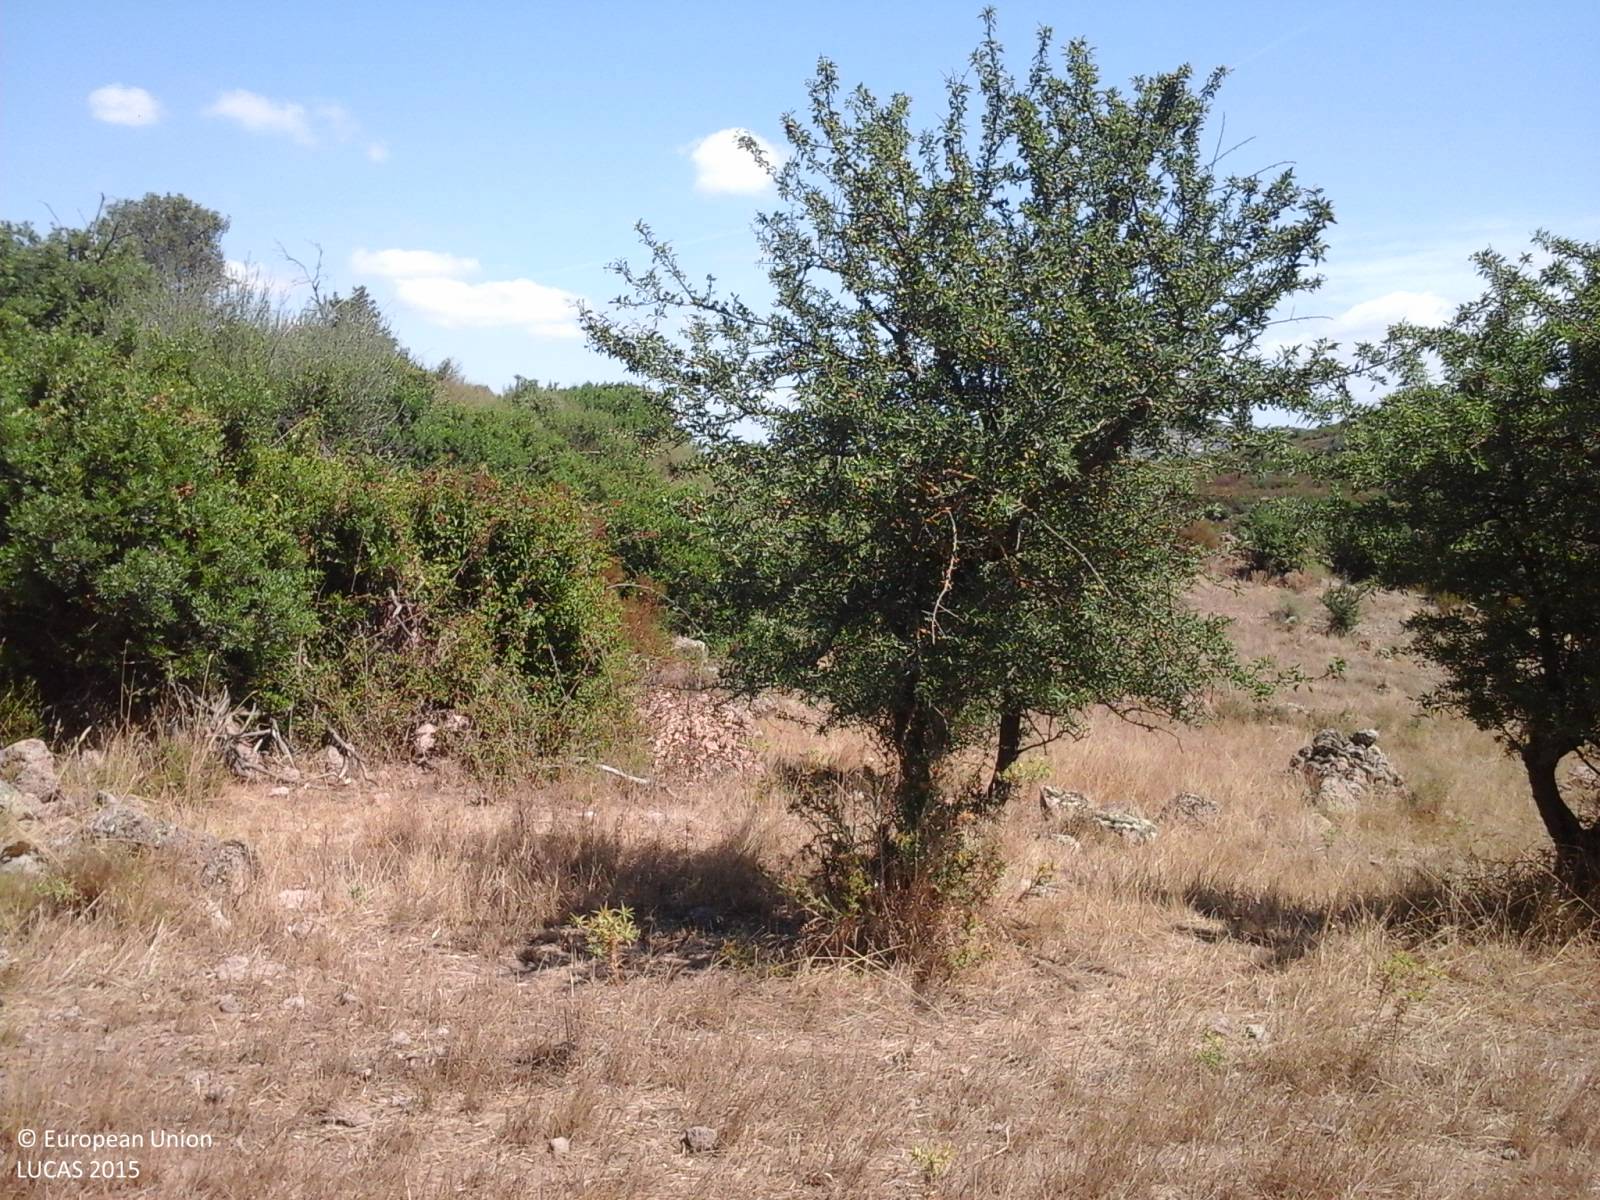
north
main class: Grassland
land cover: Grassland with sparse tree/shrub cover
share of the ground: 25 - 50 %
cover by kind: herbaceous plants 85 %, shrubs 10 %, broadleaved forest trees 5 %
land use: Agriculture (excluding fallow land and kitchen gardens)
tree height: < 5 m
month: July
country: IT
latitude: 40.5144
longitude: 8.8844
